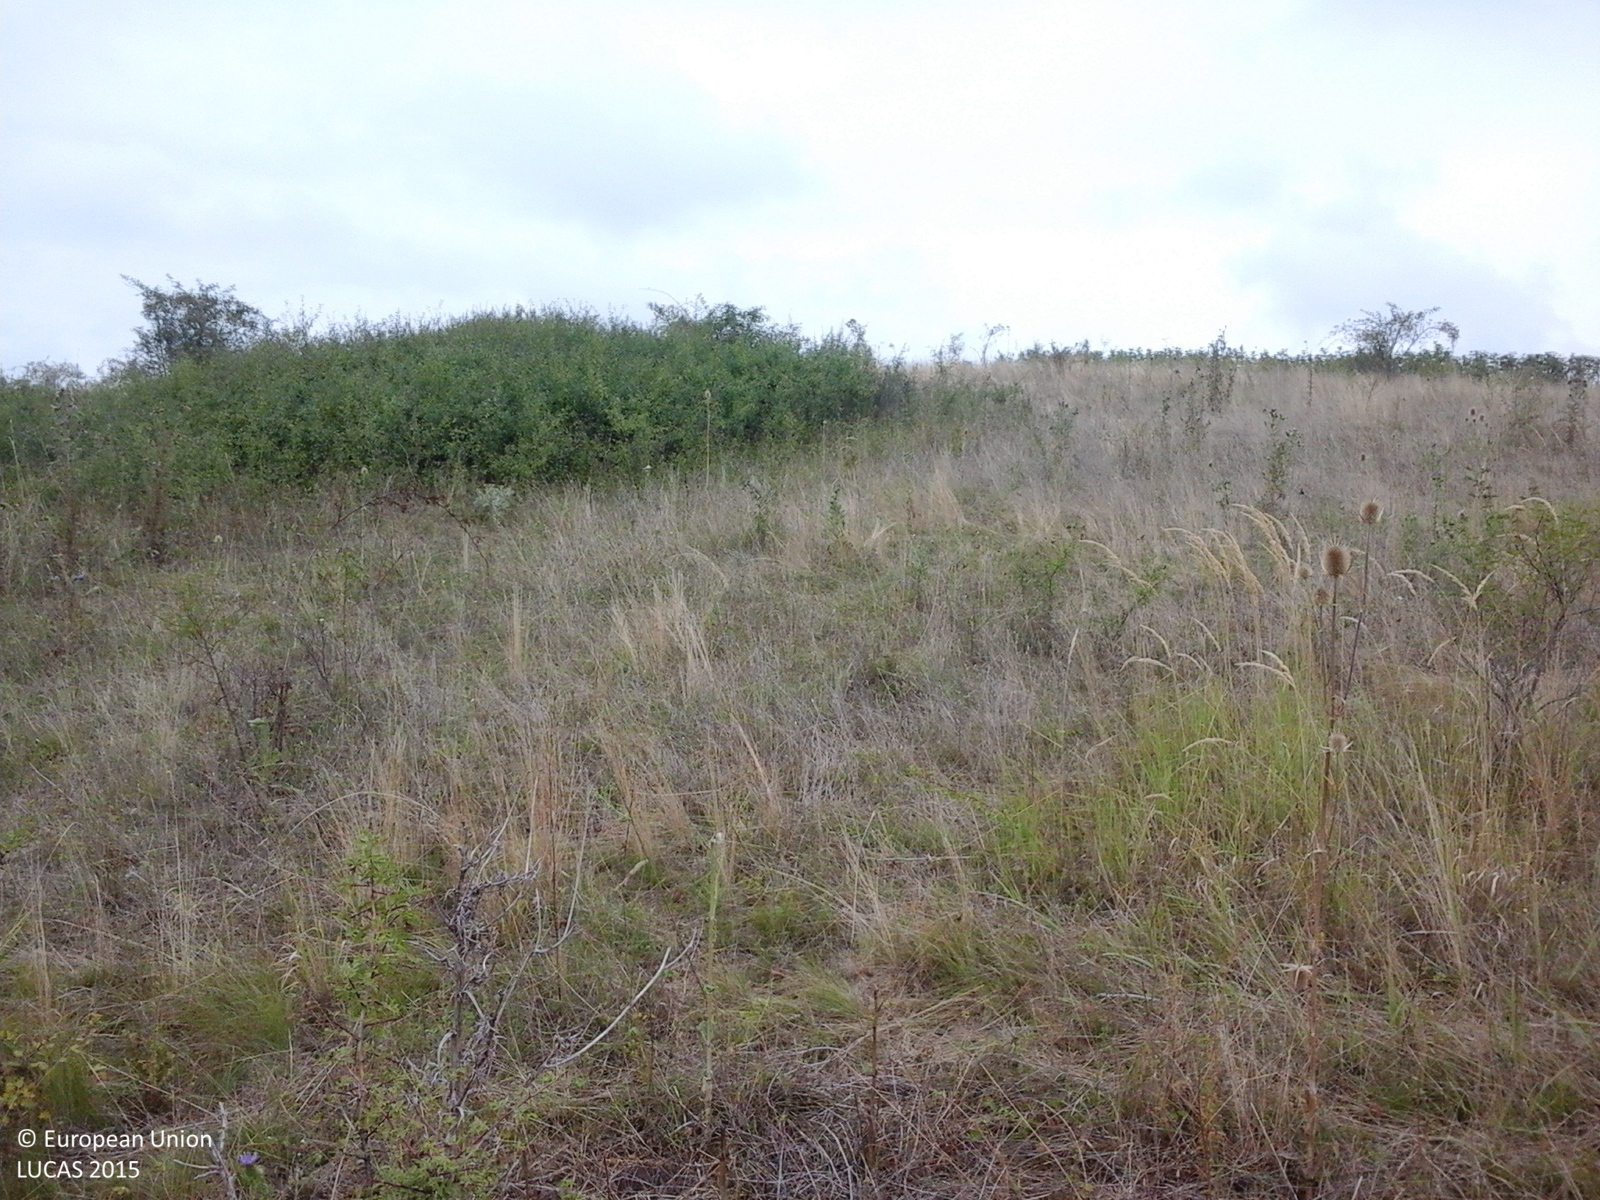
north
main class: Grassland
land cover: Grassland with sparse tree/shrub cover
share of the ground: > 75 %
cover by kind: herbaceous plants 85 %, shrubs 10 %, broadleaved forest trees 5 %
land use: Fallow land
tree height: < 5 m
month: August
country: RO
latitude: 46.0327
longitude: 21.5476
